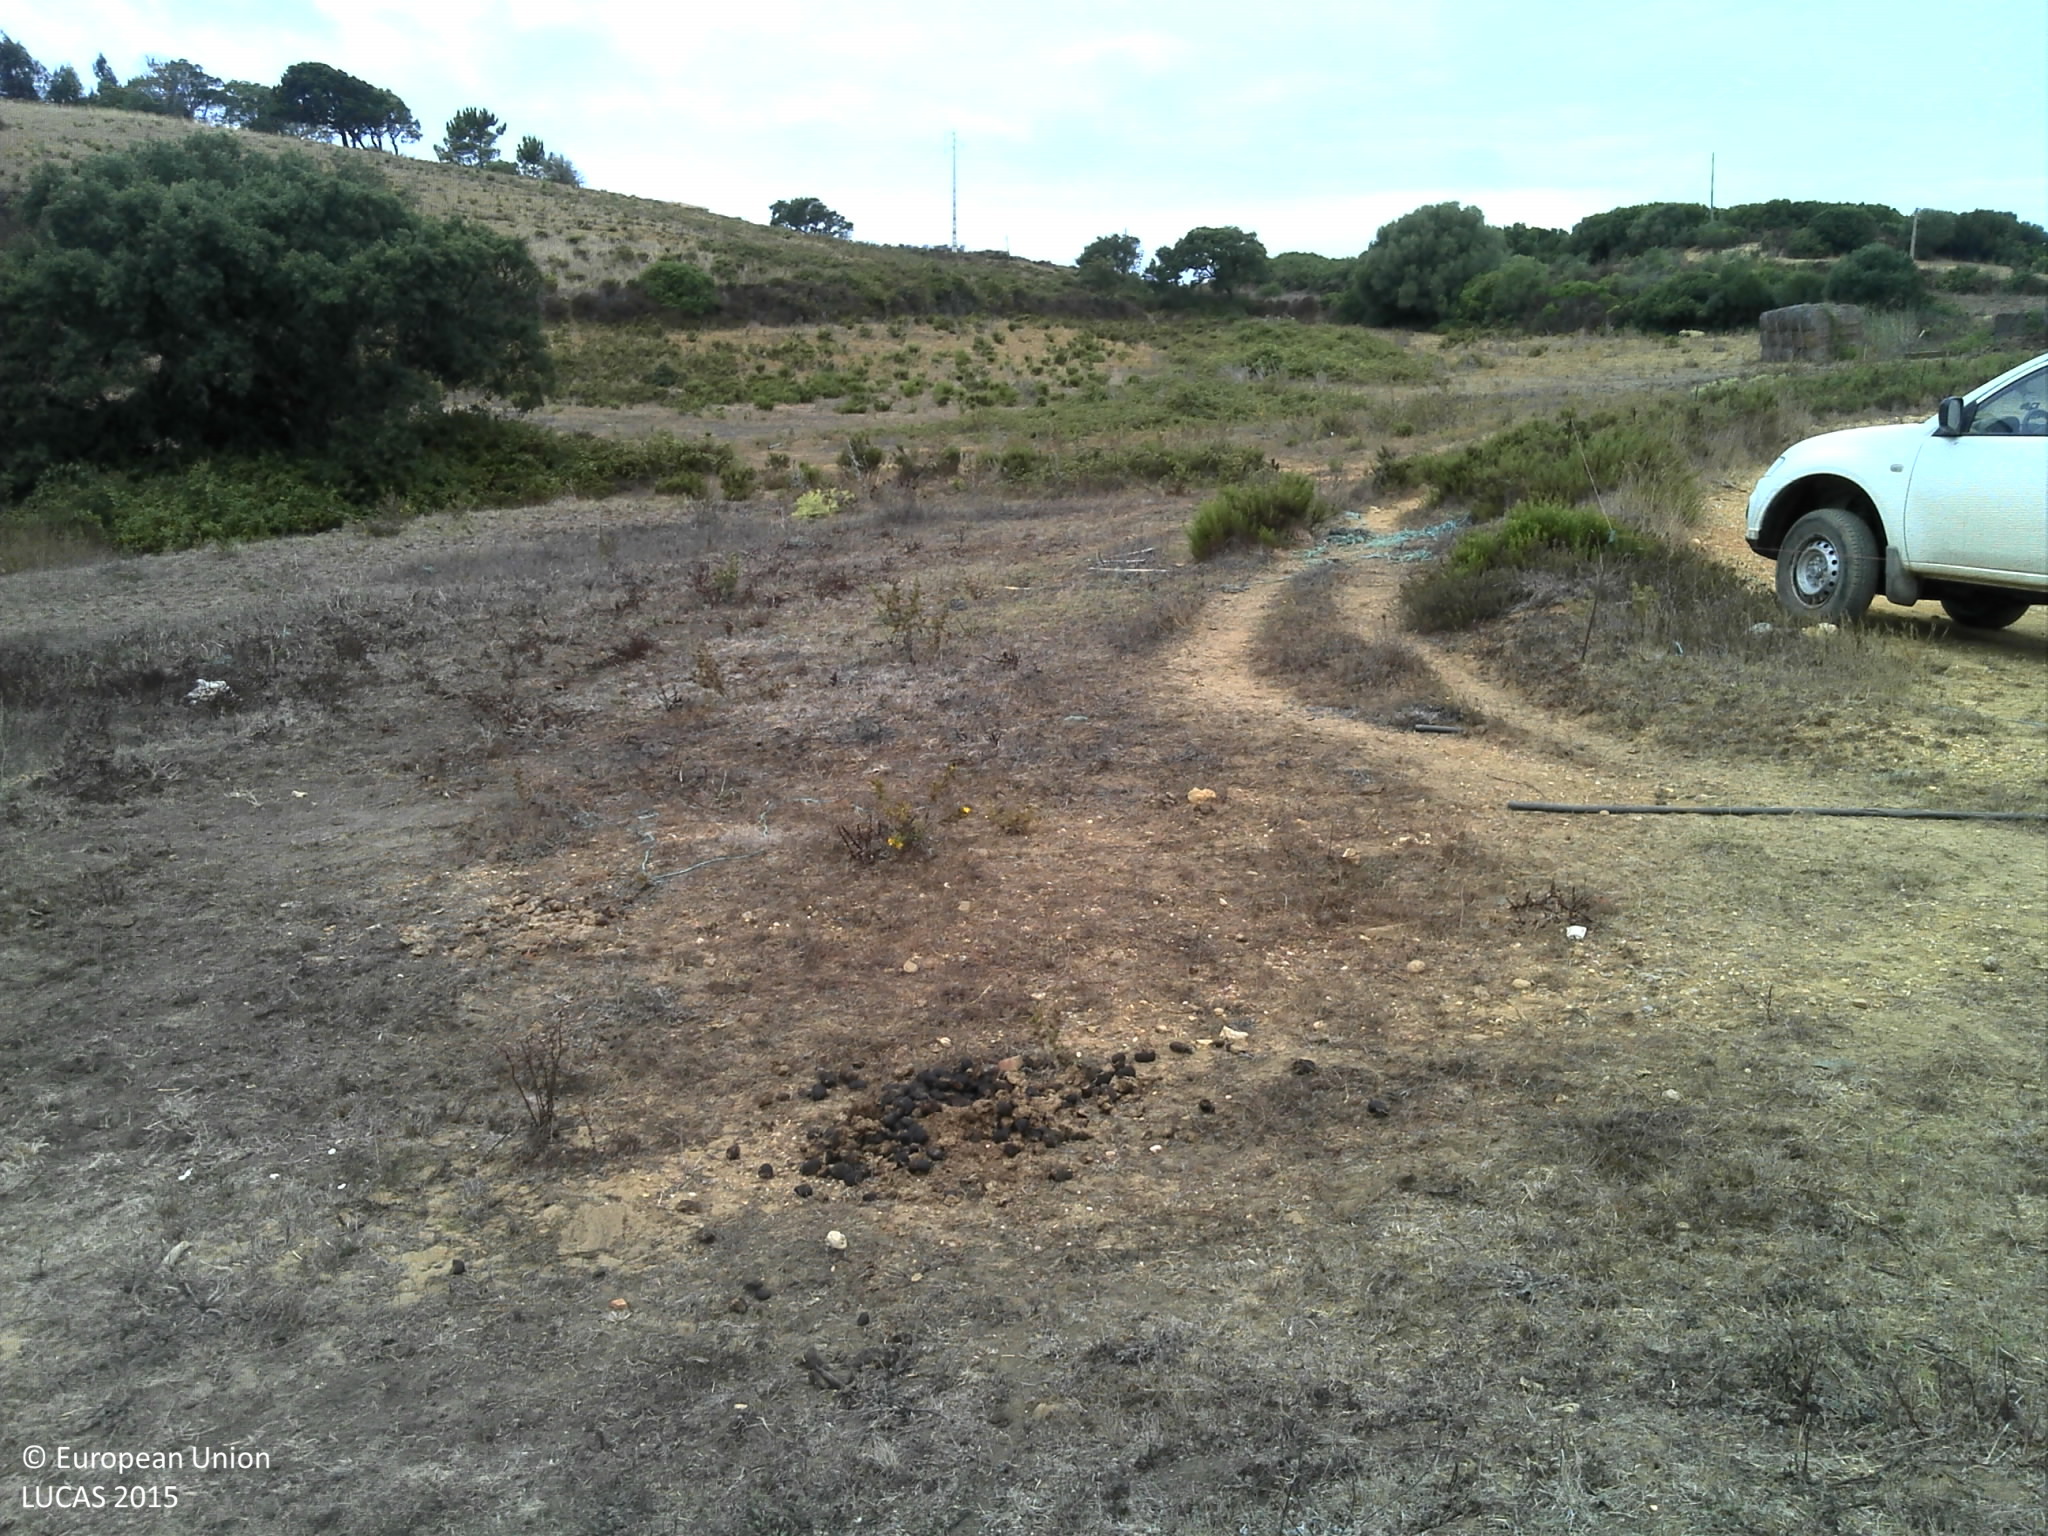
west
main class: Grassland
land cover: Grassland without tree/shrub cover
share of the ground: 25 - 50 %
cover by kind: herbaceous plants 50 %, unconsolidated bare surface 50 %
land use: Agriculture (excluding fallow land and kitchen gardens)
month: July
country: PT
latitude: 37.3411
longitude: -8.7850
